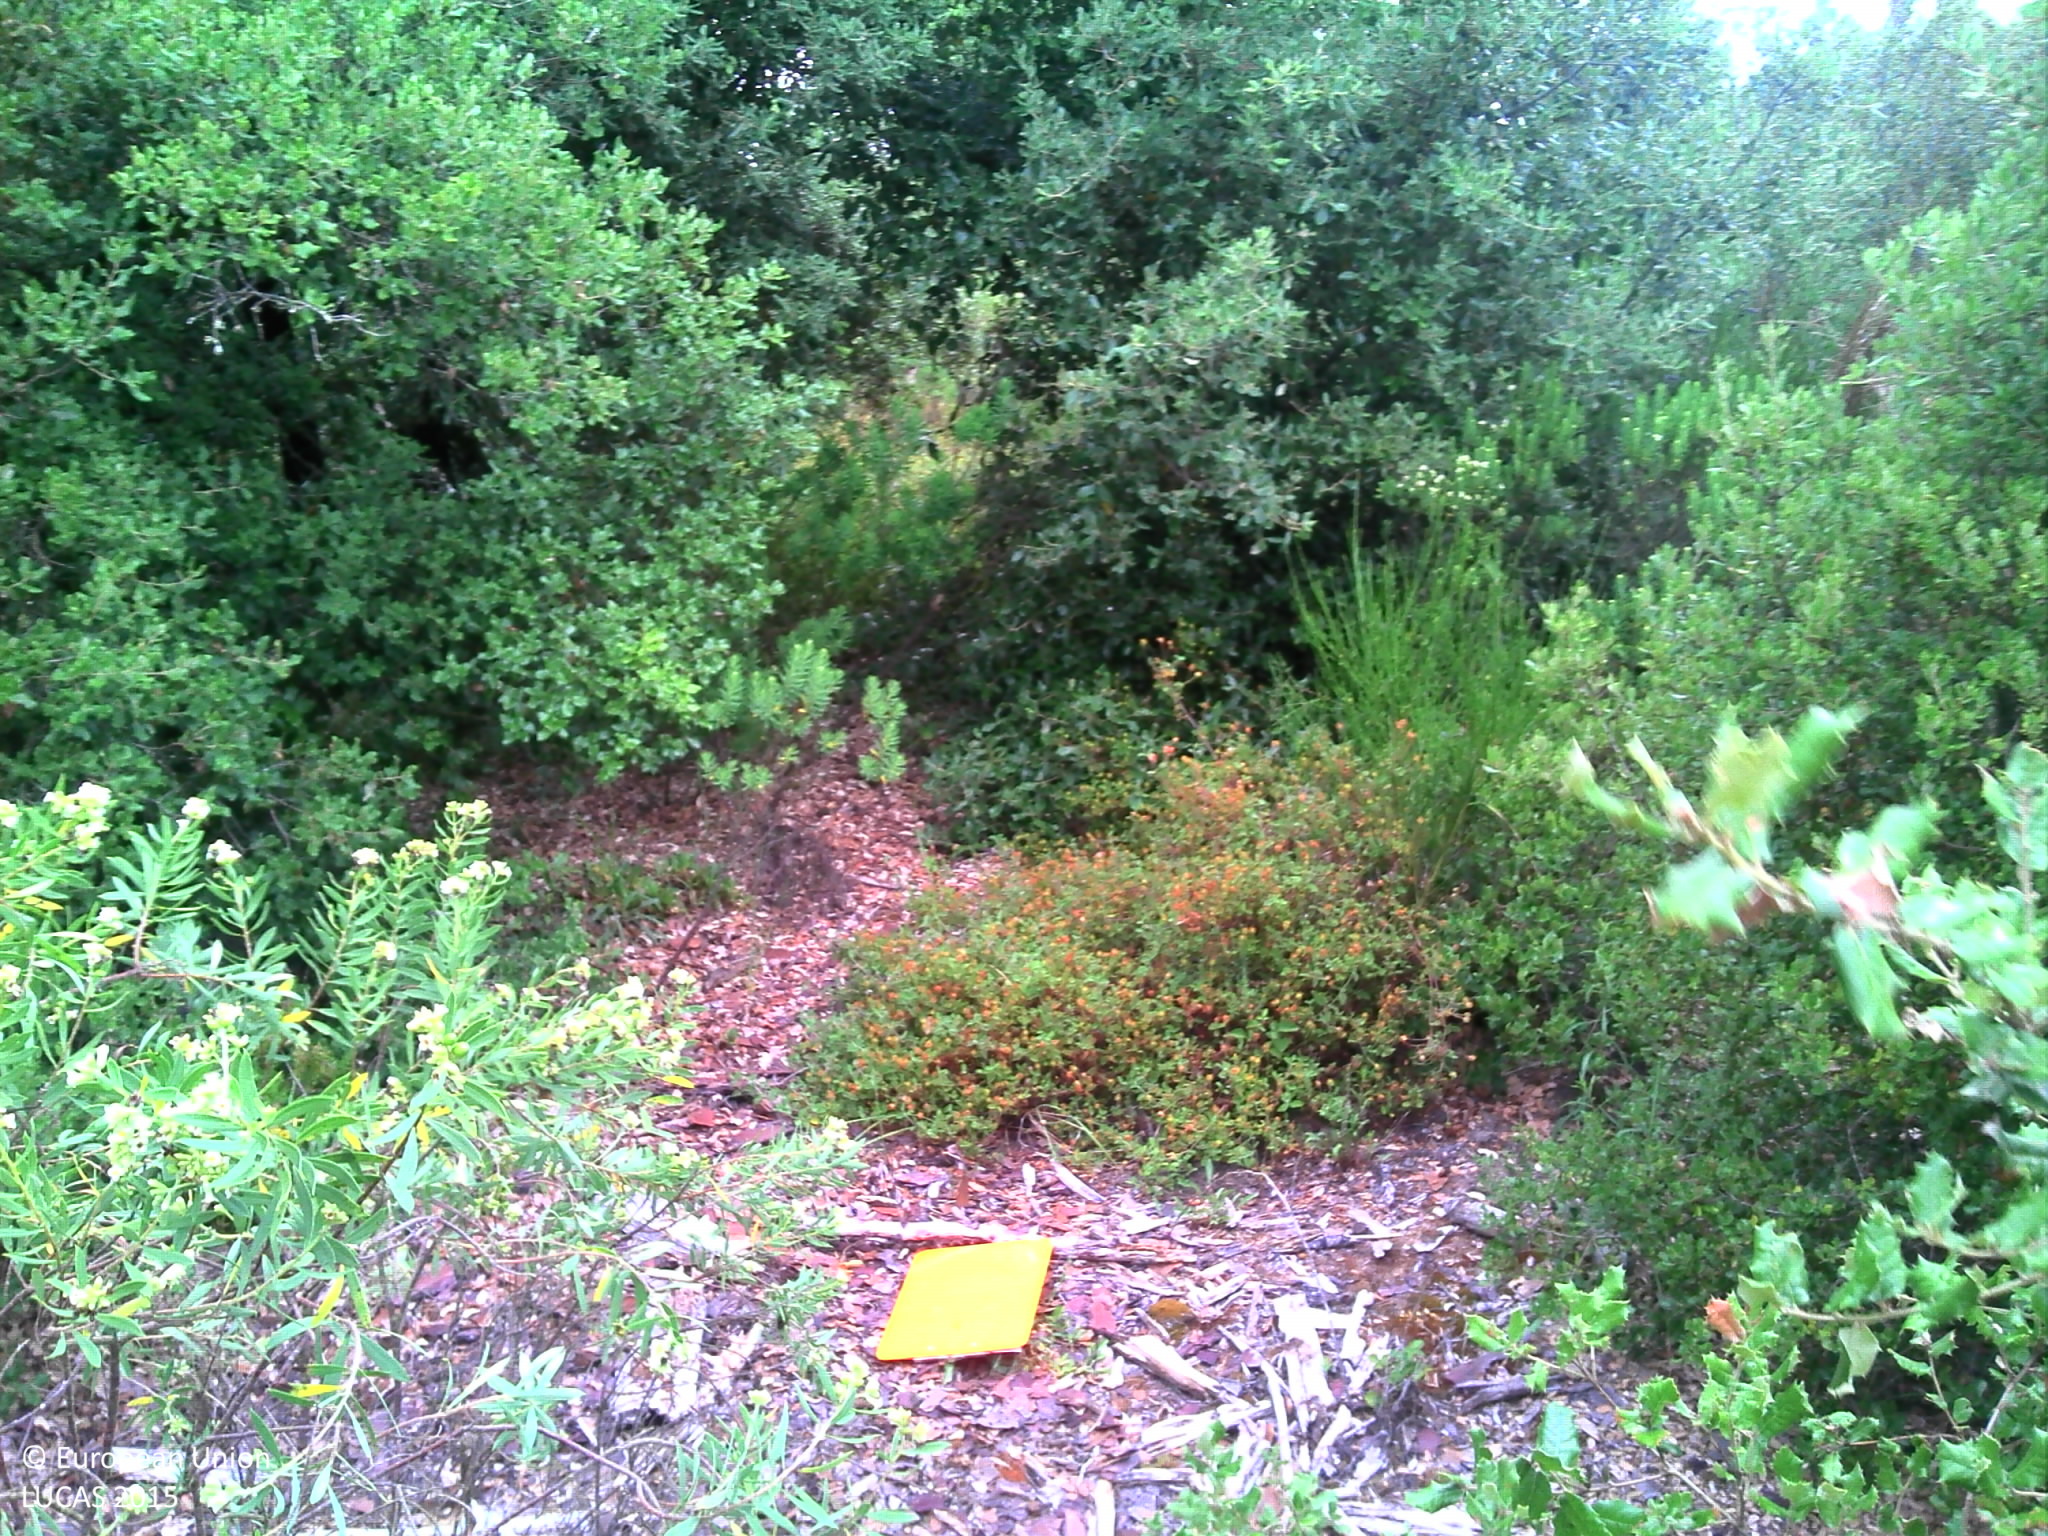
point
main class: Woodland
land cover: Pine dominated mixed woodland
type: coniferous forest of the mediterranean region
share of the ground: > 75 %
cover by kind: coniferous forest trees 75 %, broadleaved forest trees 25 %
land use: Forestry
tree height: > 5 m
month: June
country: FR
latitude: 45.6593
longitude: -1.1303
